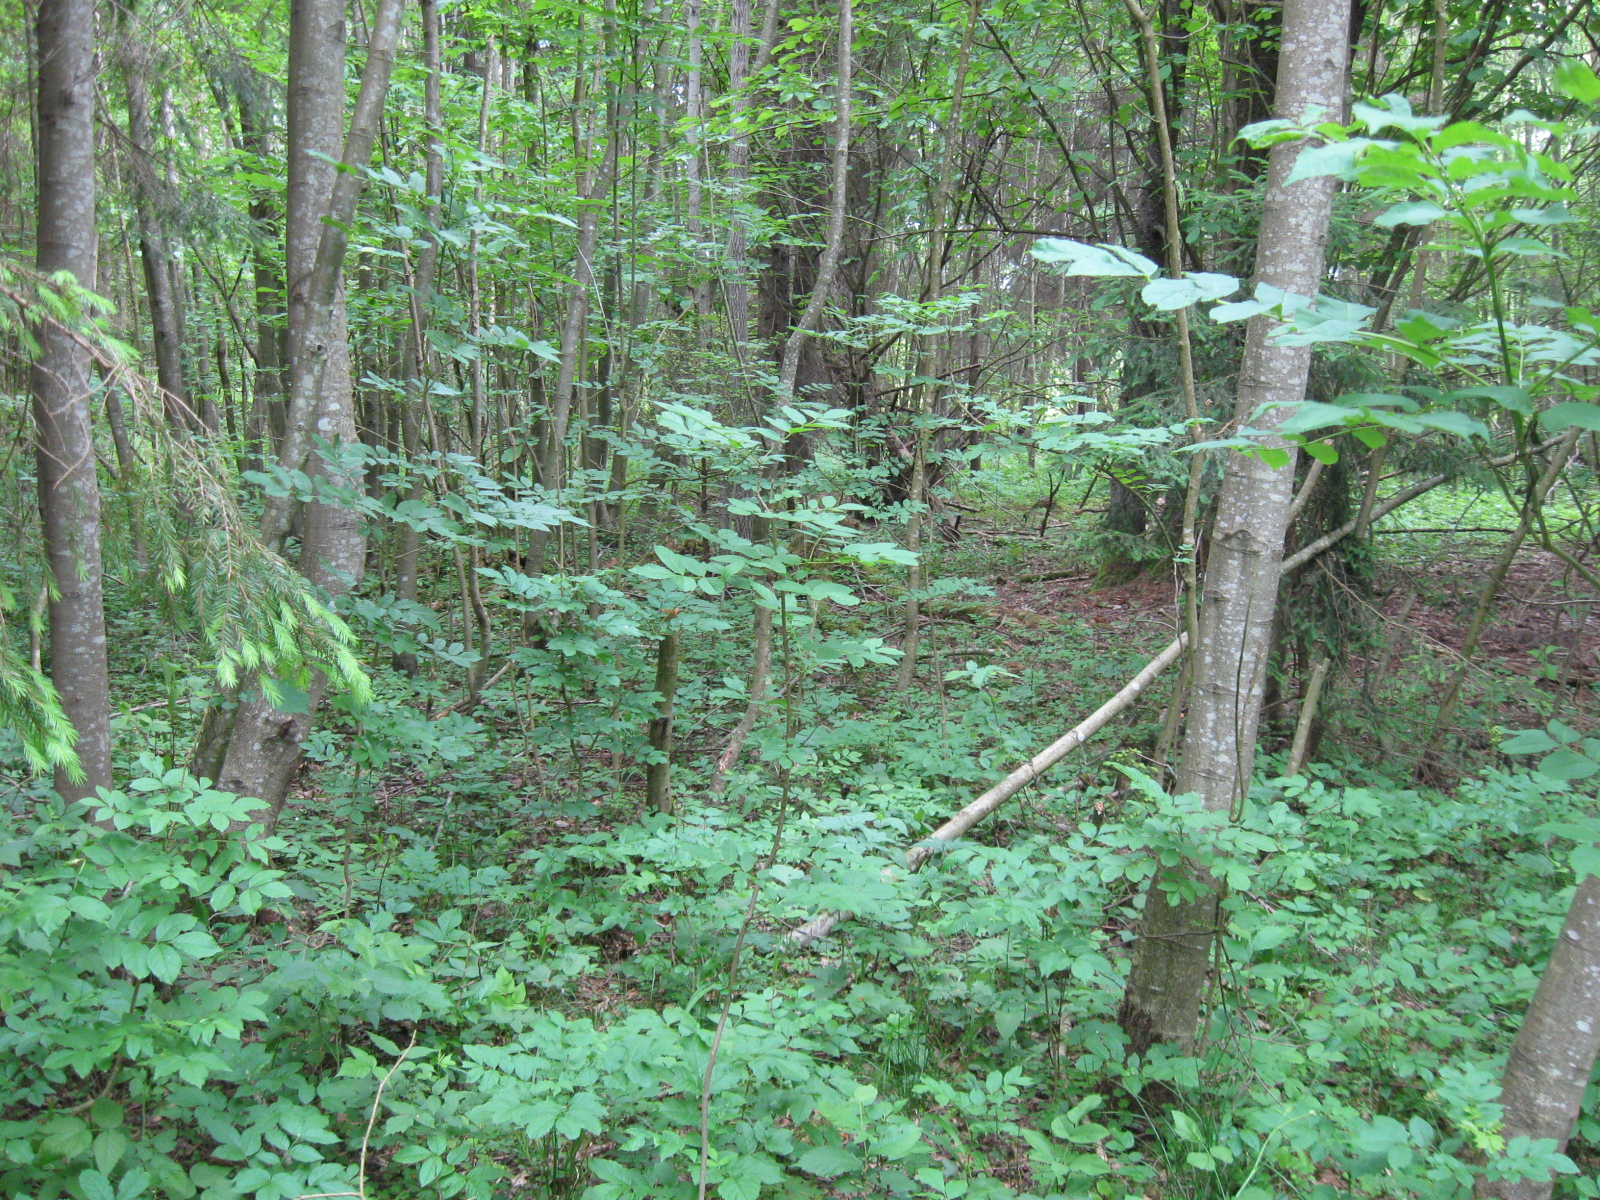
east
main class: Woodland
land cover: Spruce dominated mixed woodland
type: hemiboreal forest and nemoral coniferous forest and mixed broadleaved-coniferous forest
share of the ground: > 75 %
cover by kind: broadleaved forest trees 55 %, coniferous forest trees 35 %, herbaceous plants 10 %
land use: Forestry
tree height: > 5 m
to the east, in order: Spruce dominated mixed woodland; Other mixed woodland; Broadleaved woodland
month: June
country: LT
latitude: 55.0309
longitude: 23.8393
